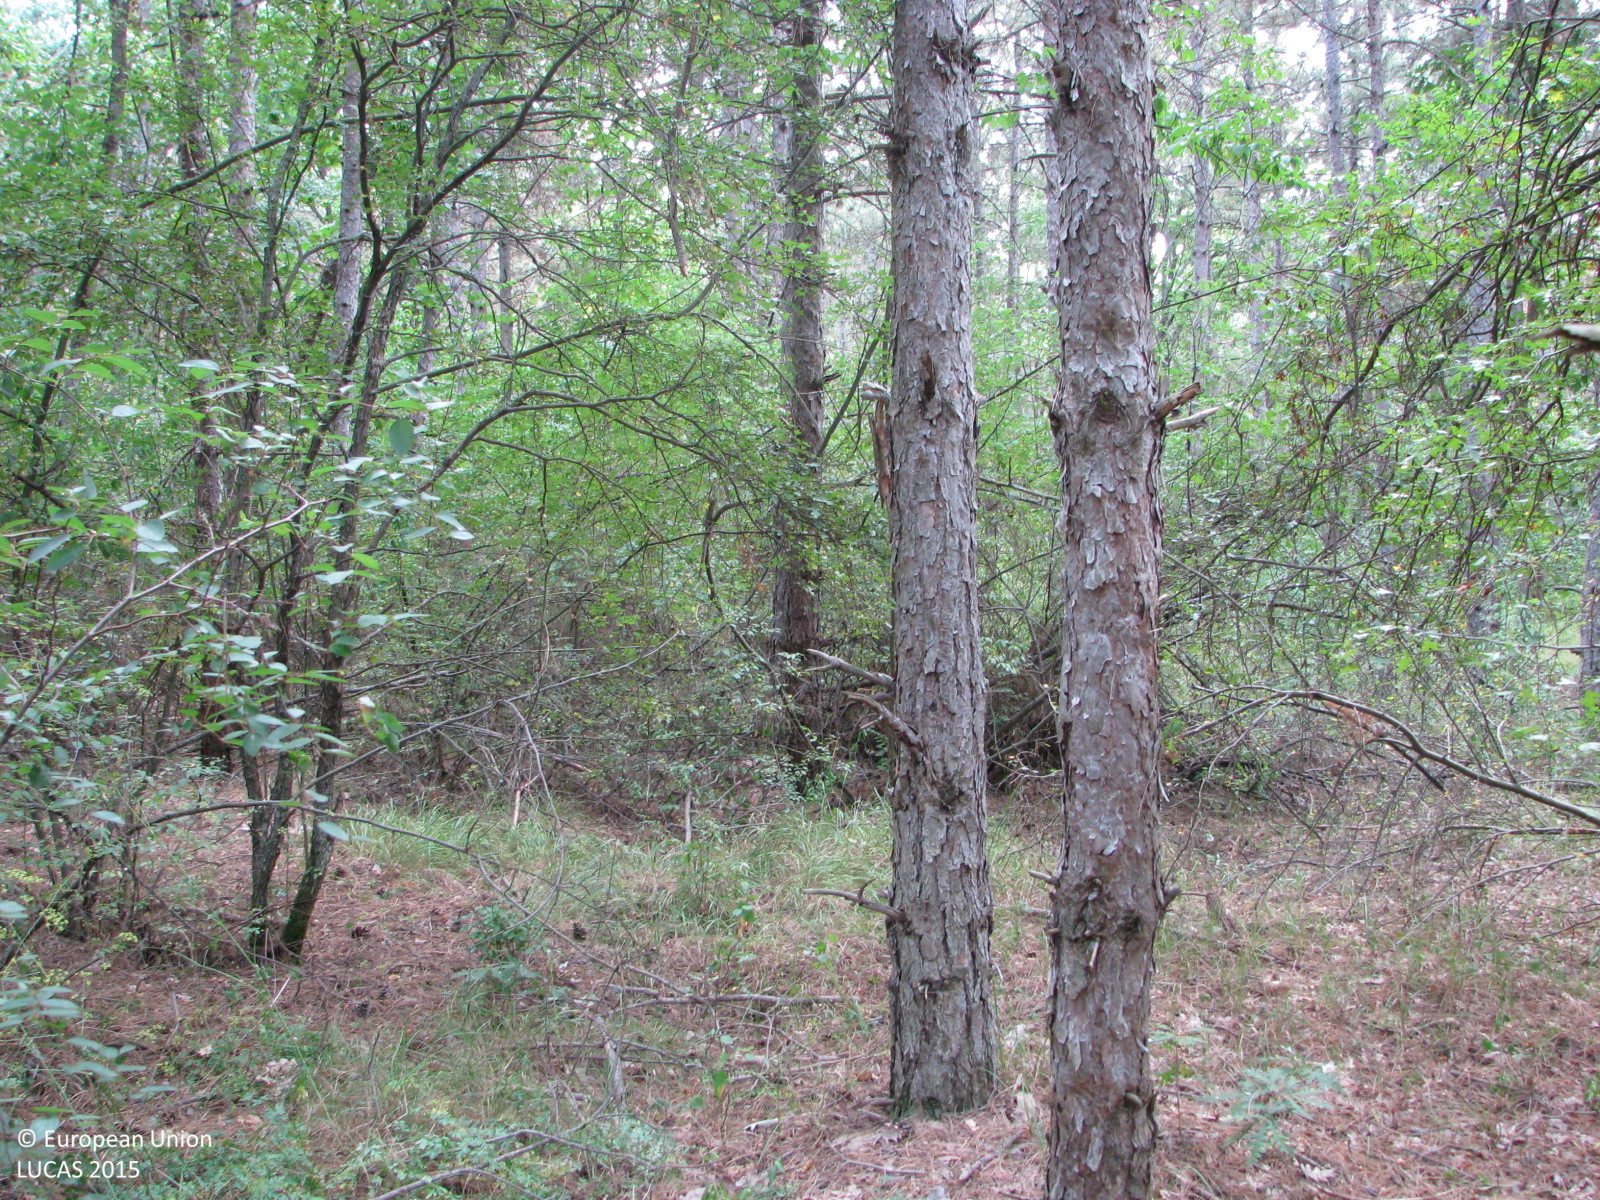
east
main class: Woodland
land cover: Pine dominated mixed woodland
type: hemiboreal forest and nemoral coniferous forest and mixed broadleaved-coniferous forest
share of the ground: > 75 %
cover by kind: coniferous forest trees 50 %, broadleaved forest trees 25 %, shrubs 15 %, herbaceous plants 10 %
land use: Forestry
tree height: > 5 m
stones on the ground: < 10 %
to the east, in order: Pine dominated mixed woodland; Tracks; Pine dominated mixed woodland
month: August
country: BG
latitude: 42.1051
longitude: 26.7942
